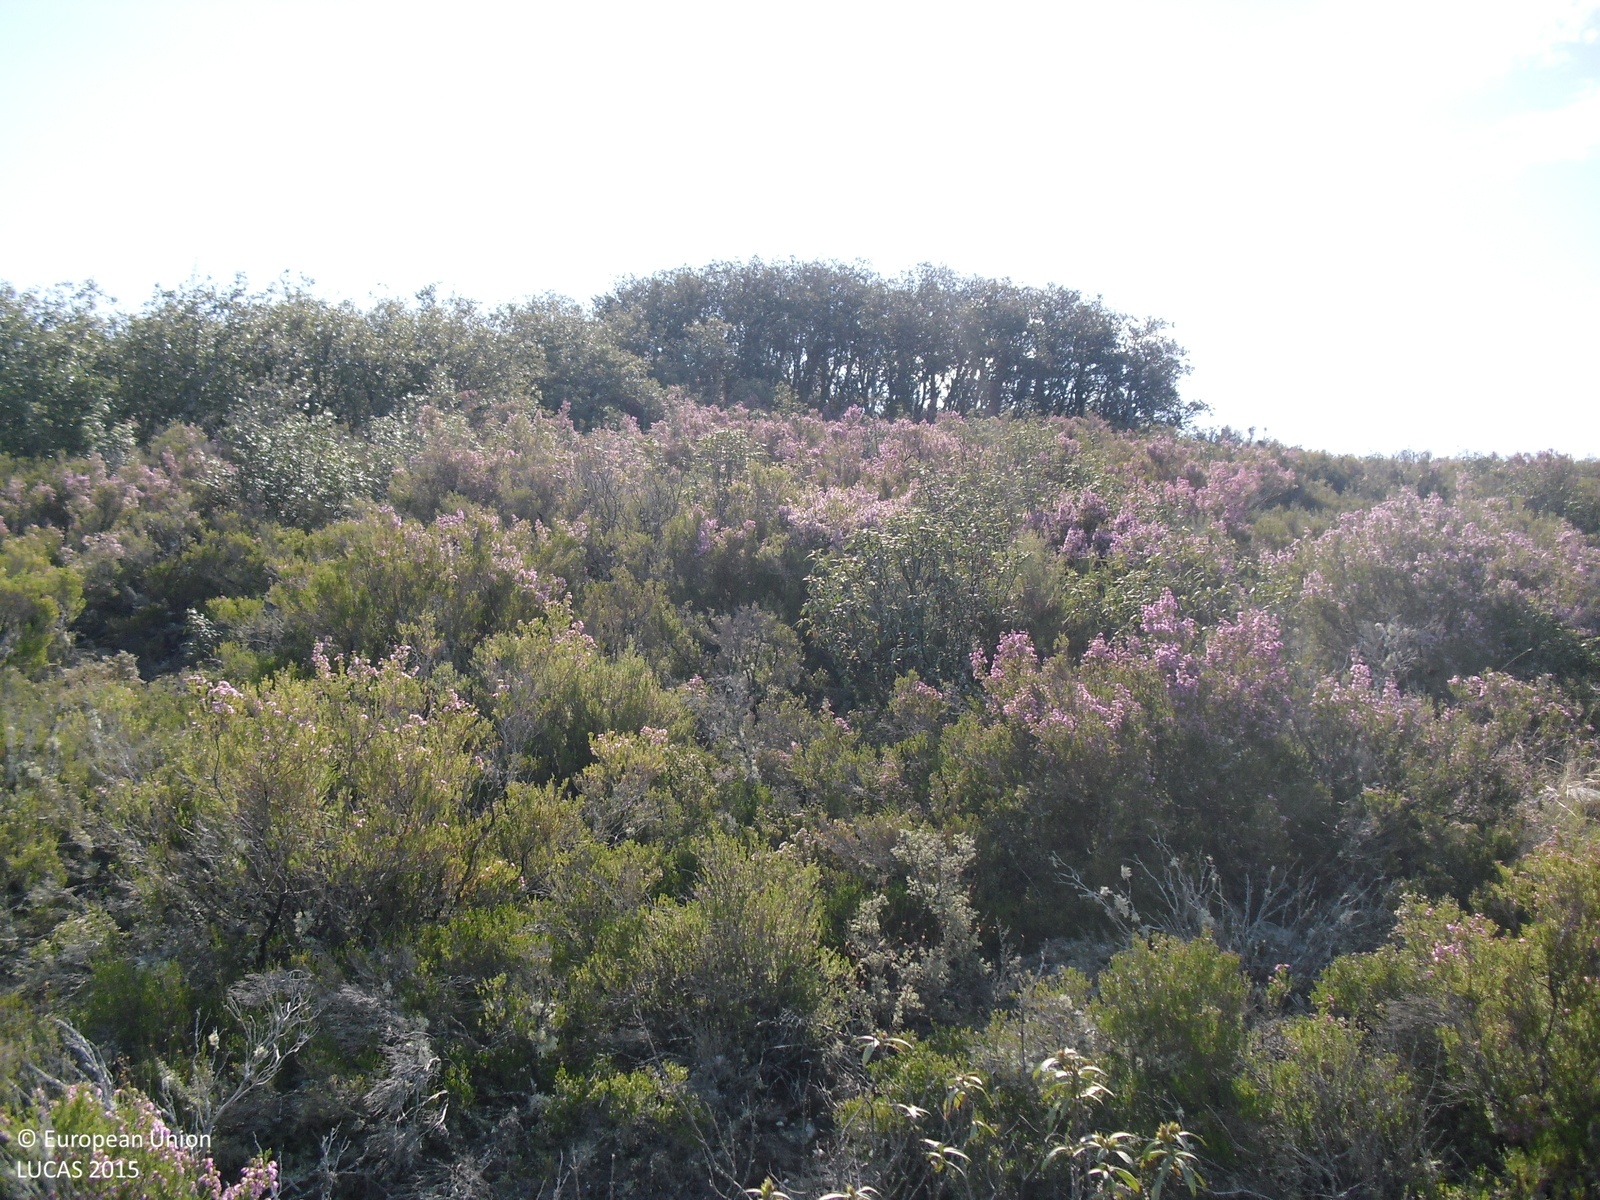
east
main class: Shrubland
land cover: Shrubland without tree cover
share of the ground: > 75 %
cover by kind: shrubs 100 %
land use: Semi-natural and natural areas not in use
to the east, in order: Shrubland without tree cover; Rock outcrops; Shrubland without tree cover
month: April
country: ES
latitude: 39.4691
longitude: -5.3812
